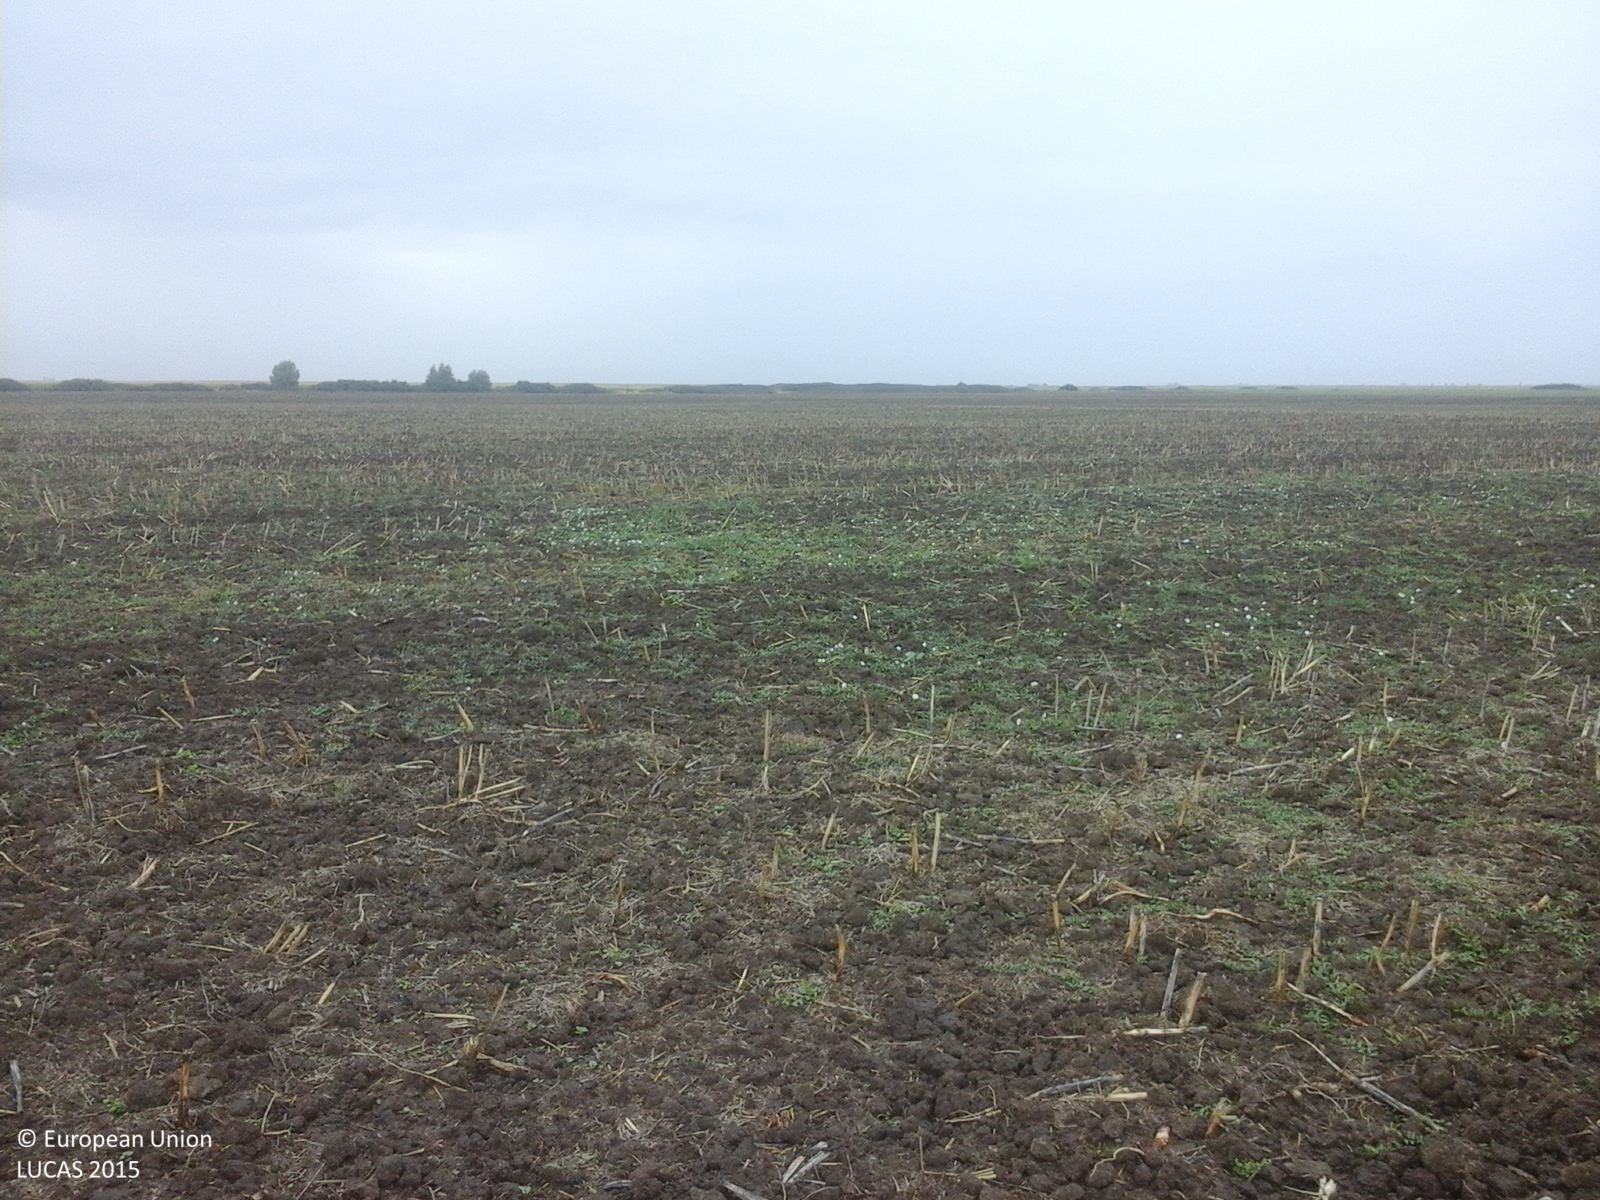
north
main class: Cropland
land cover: Rape and turnip rape
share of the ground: < 10 %
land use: Agriculture (excluding fallow land and kitchen gardens)
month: August
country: RO
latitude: 45.4209
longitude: 20.9782
